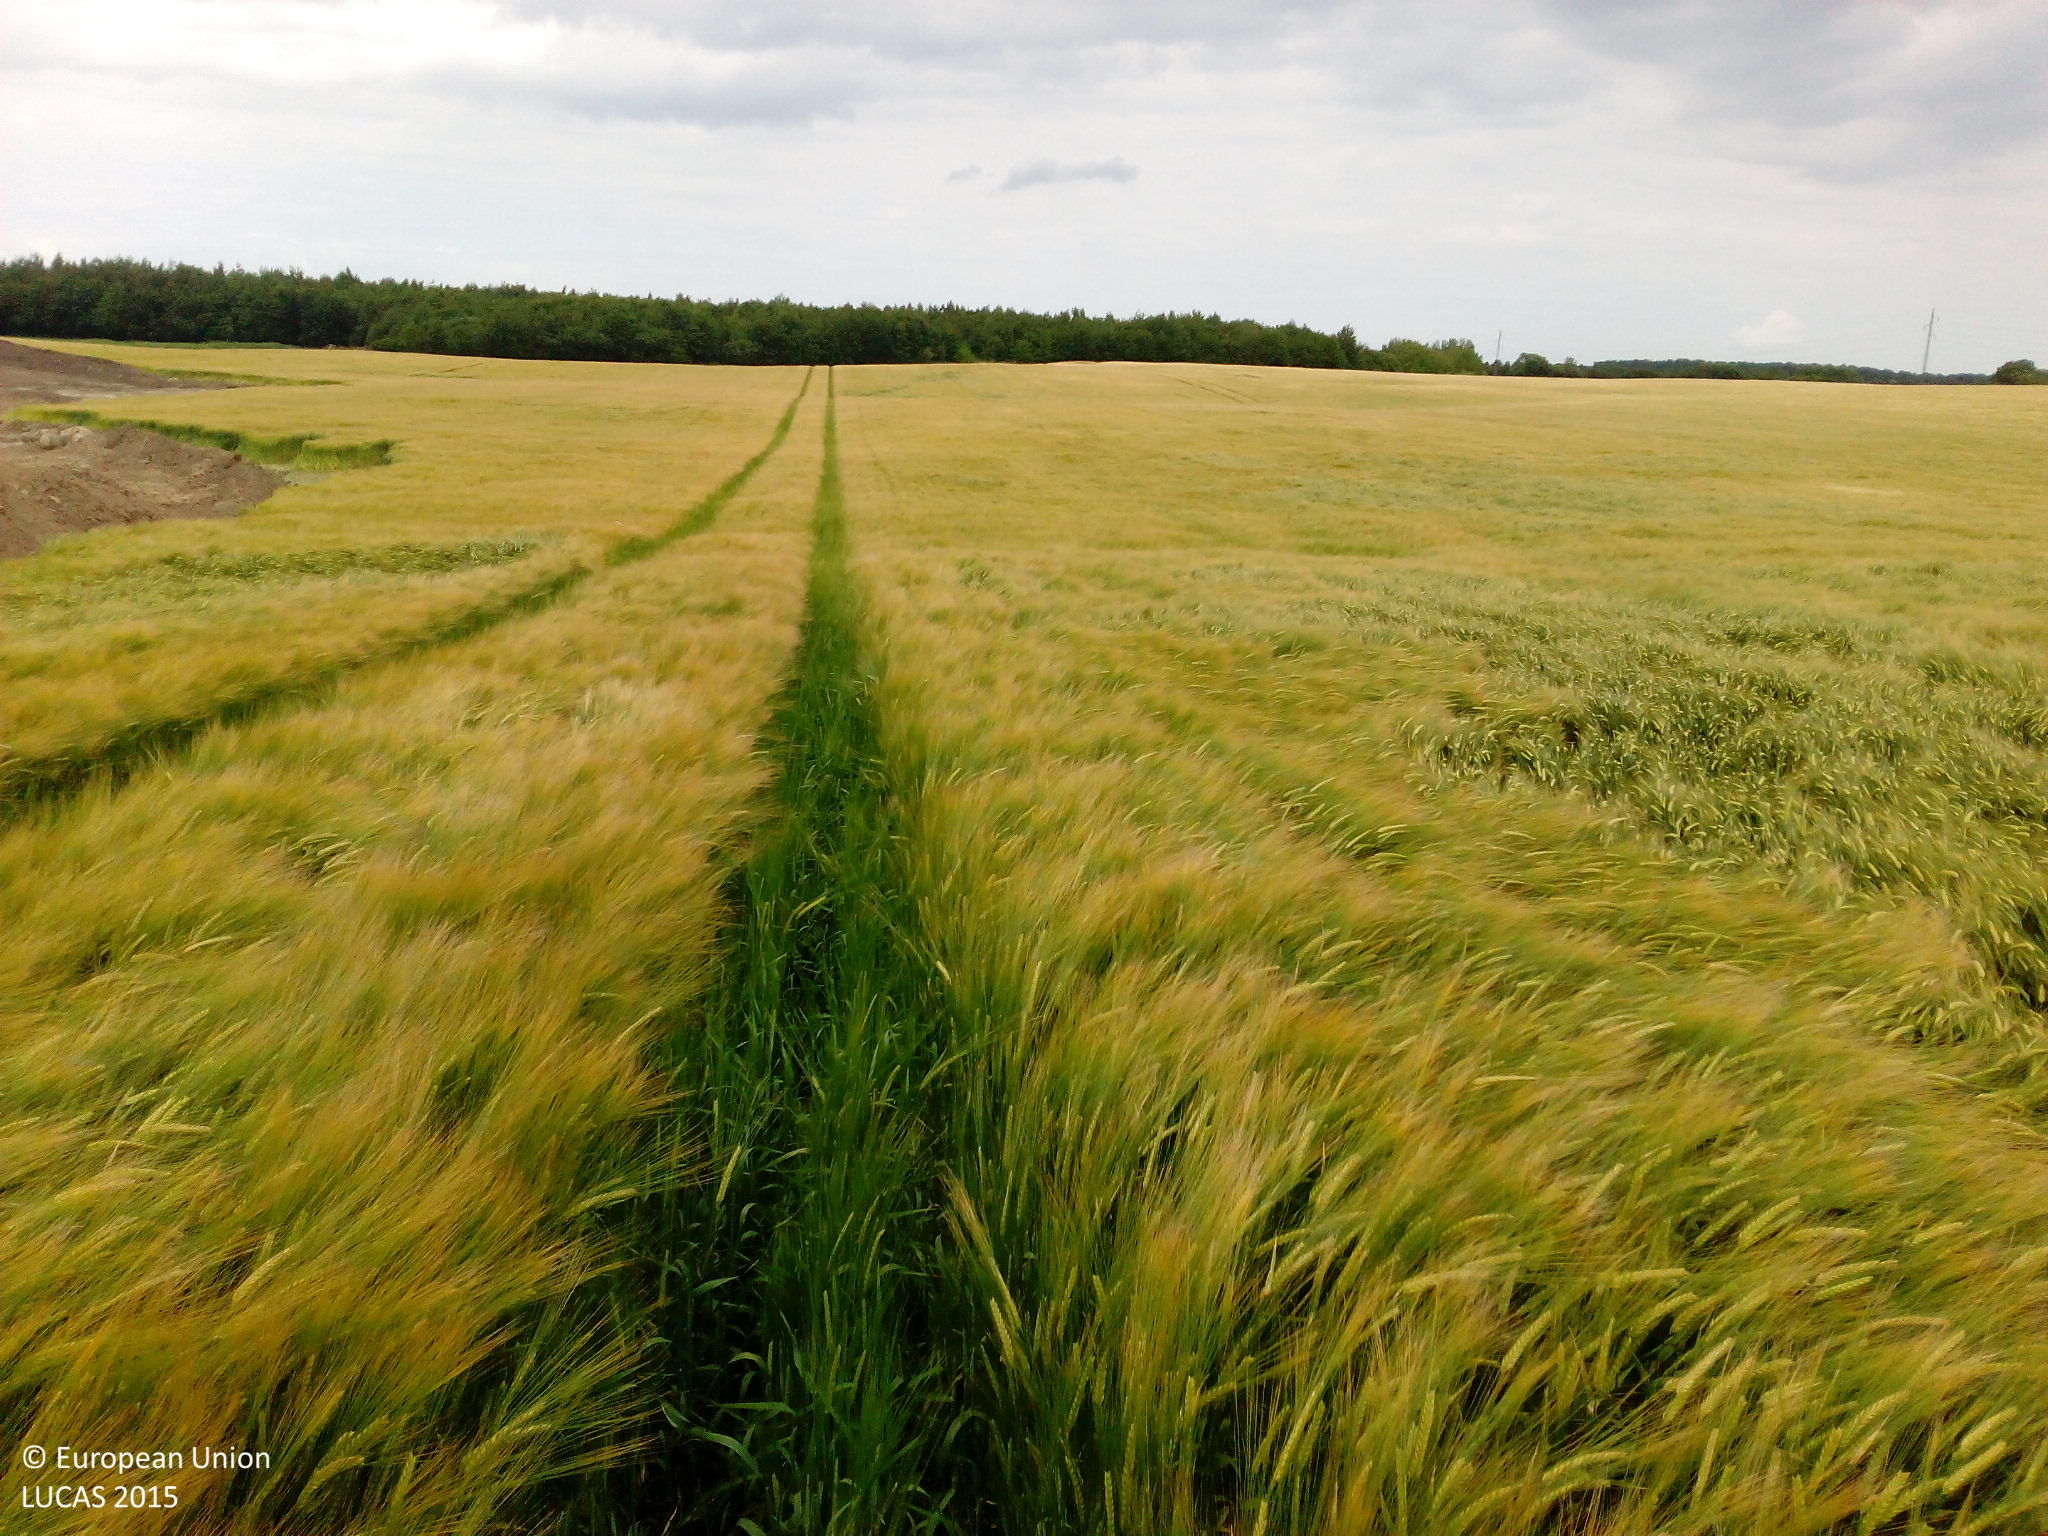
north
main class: Cropland
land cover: Barley
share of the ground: > 75 %
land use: Agriculture (excluding fallow land and kitchen gardens)
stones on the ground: < 10 %
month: July
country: DK
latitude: 55.6902
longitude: 11.7641
